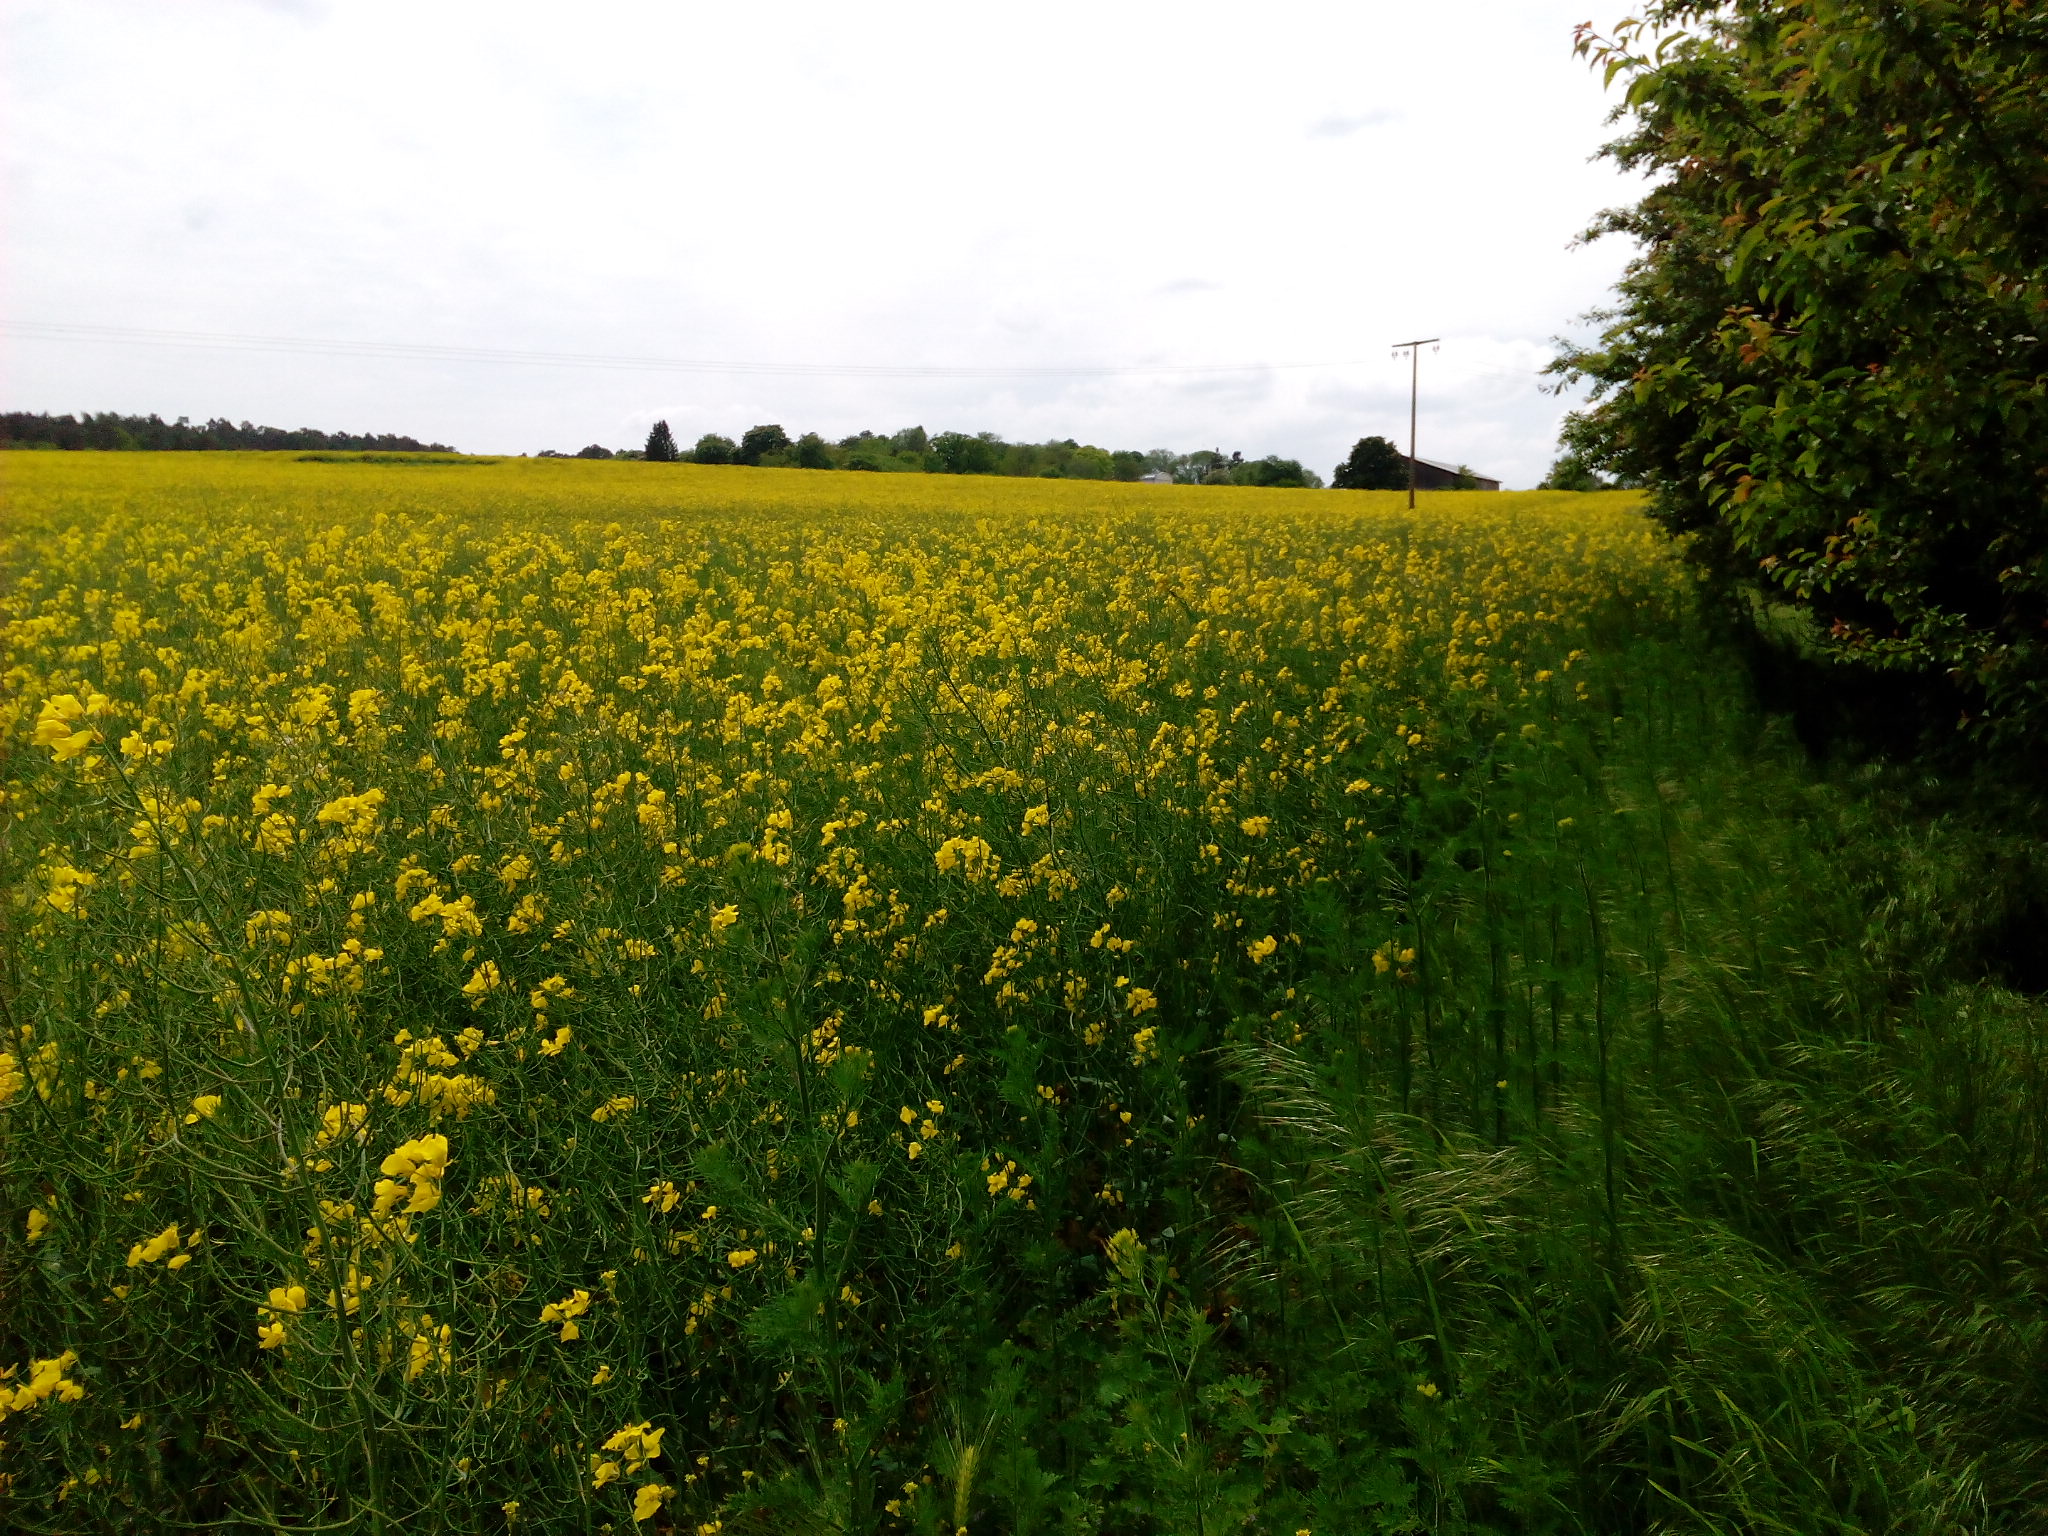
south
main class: Cropland
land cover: Rape and turnip rape
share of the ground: > 75 %
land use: Agriculture (excluding fallow land and kitchen gardens)
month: May
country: DE
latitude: 53.8038
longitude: 12.6868
